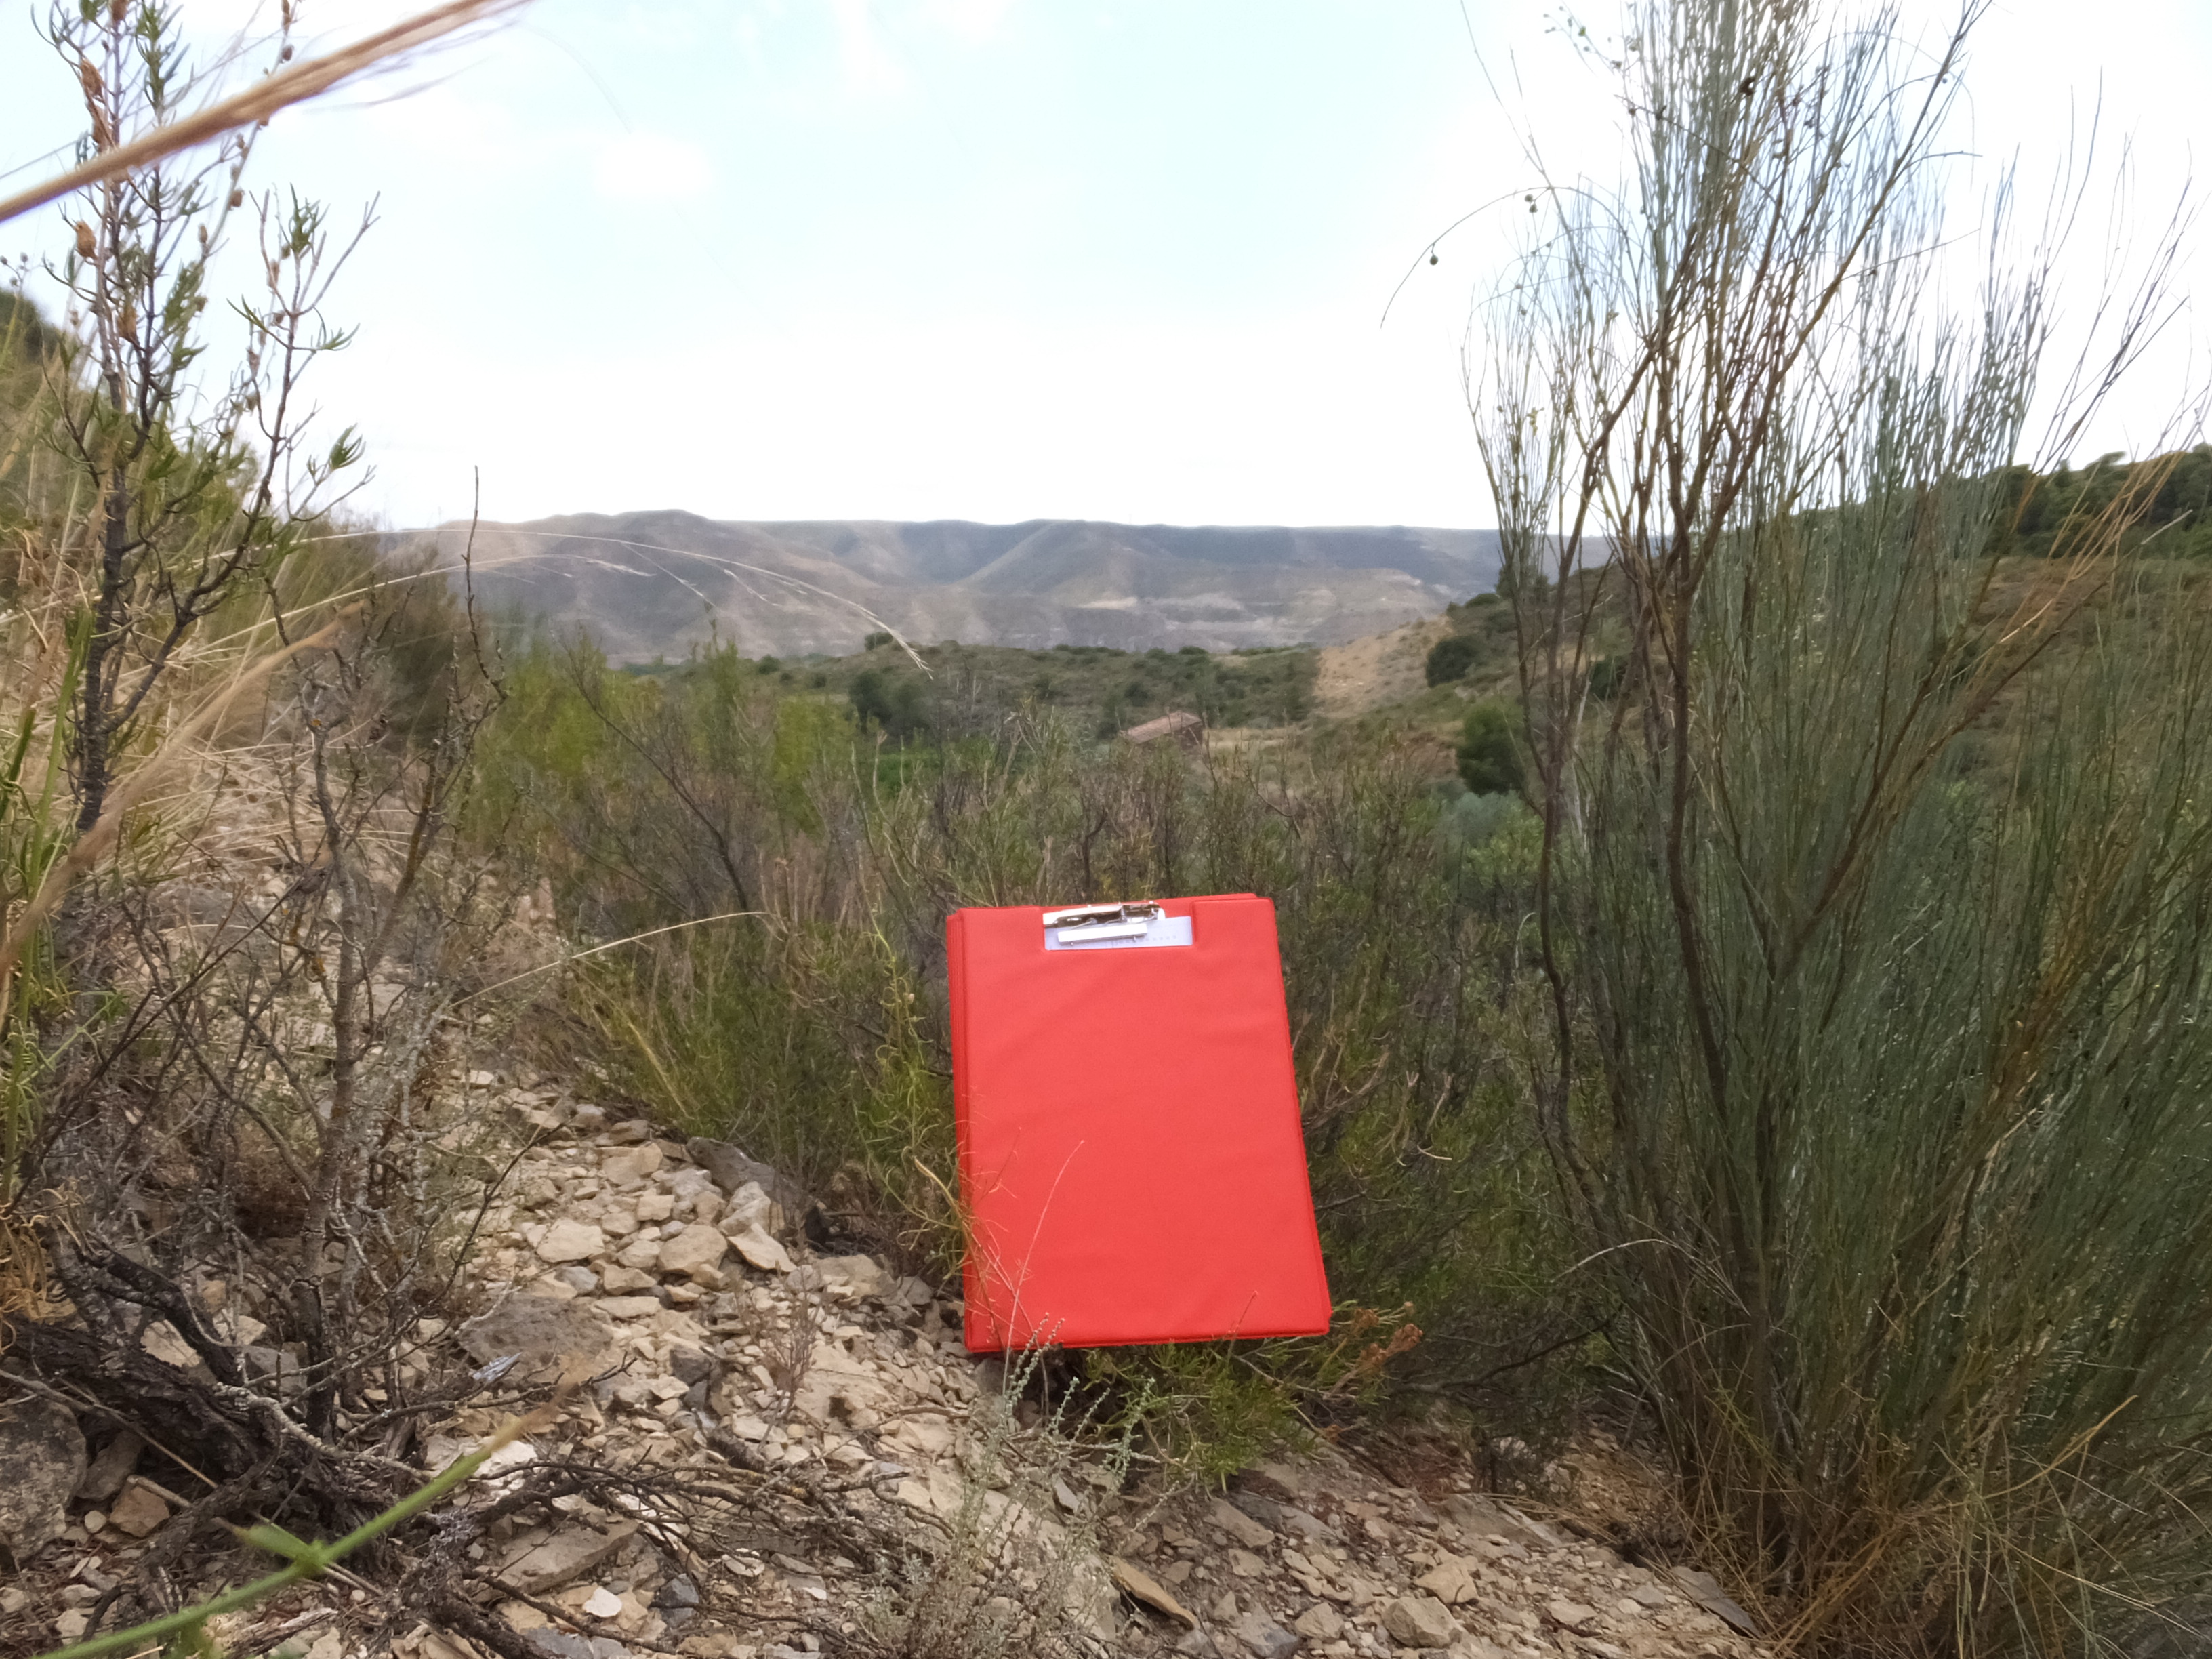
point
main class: Shrubland
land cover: Shrubland without tree cover
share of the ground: > 75 %
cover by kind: shrubs 45 %, herbaceous plants 45 %, unconsolidated bare surface 10 %
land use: Semi-natural and natural areas not in use
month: June
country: ES
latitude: 41.4268
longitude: 0.3312
